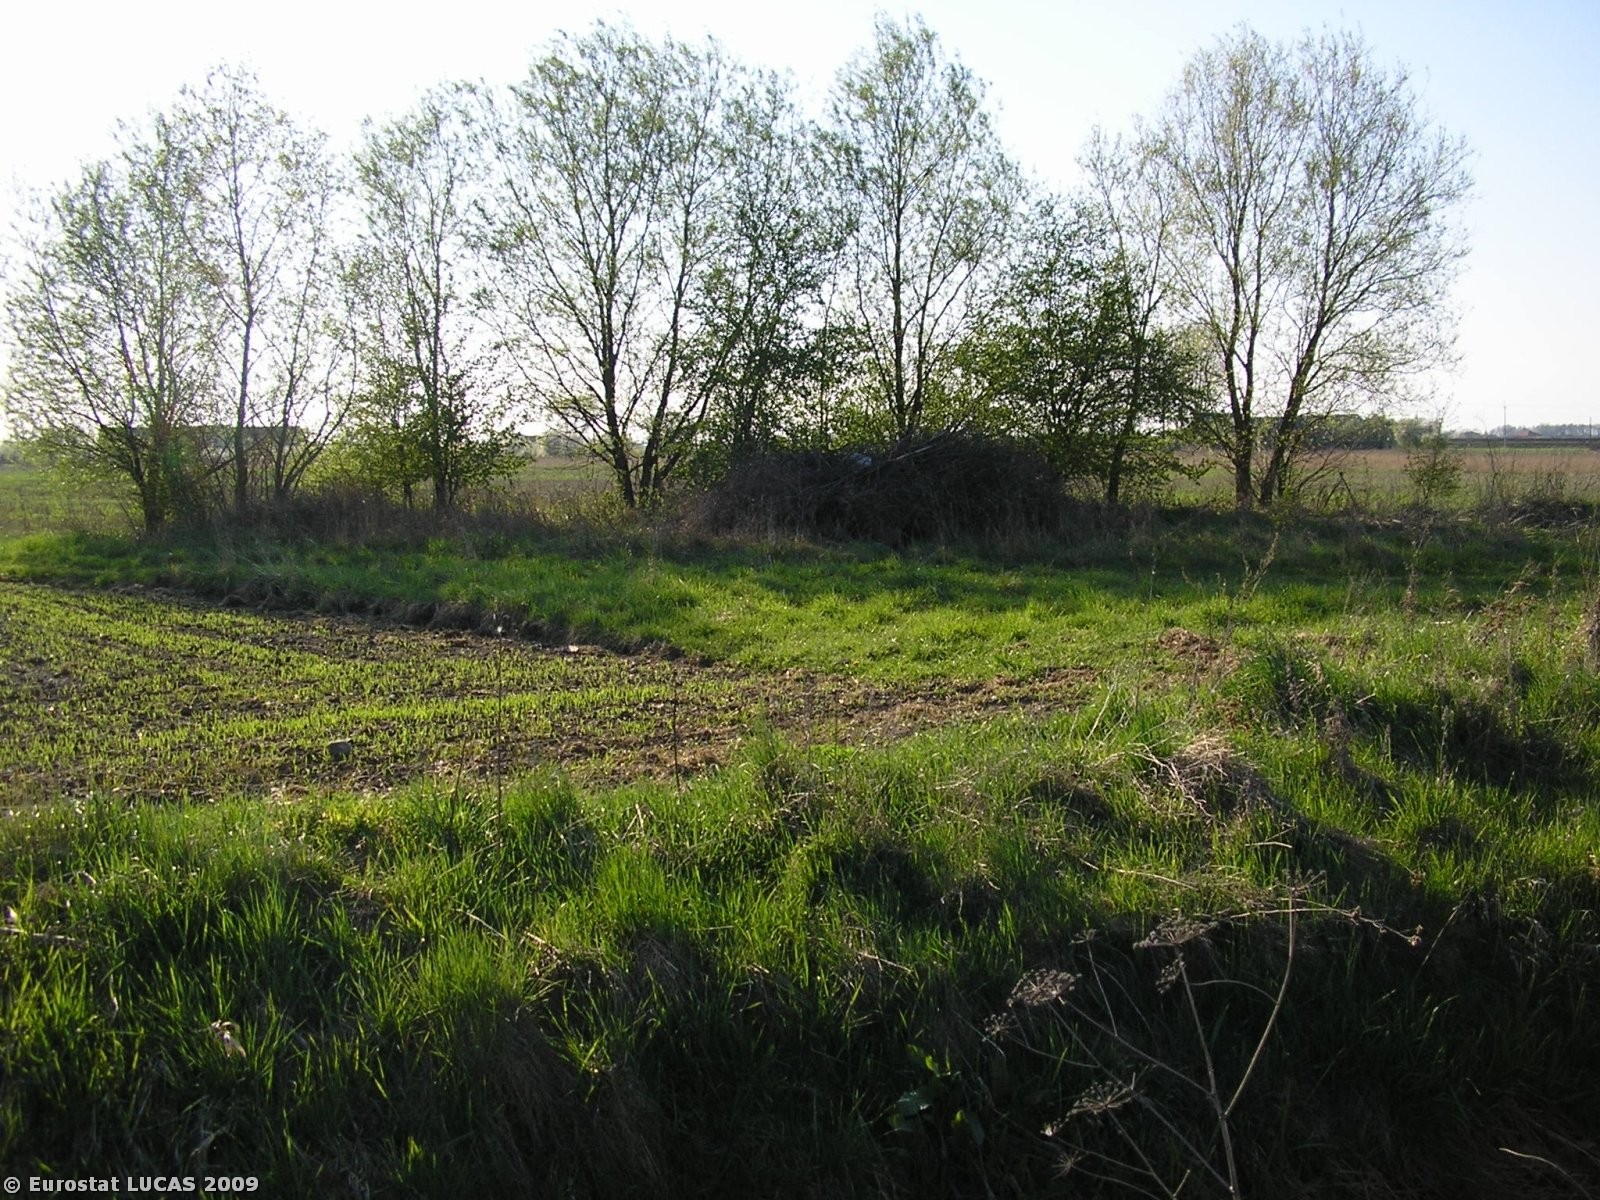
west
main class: Grassland
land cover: Spontaneously vegetated surfaces
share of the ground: > 75 %
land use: Unused
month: April
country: PL
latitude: 52.1092
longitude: 20.0941
